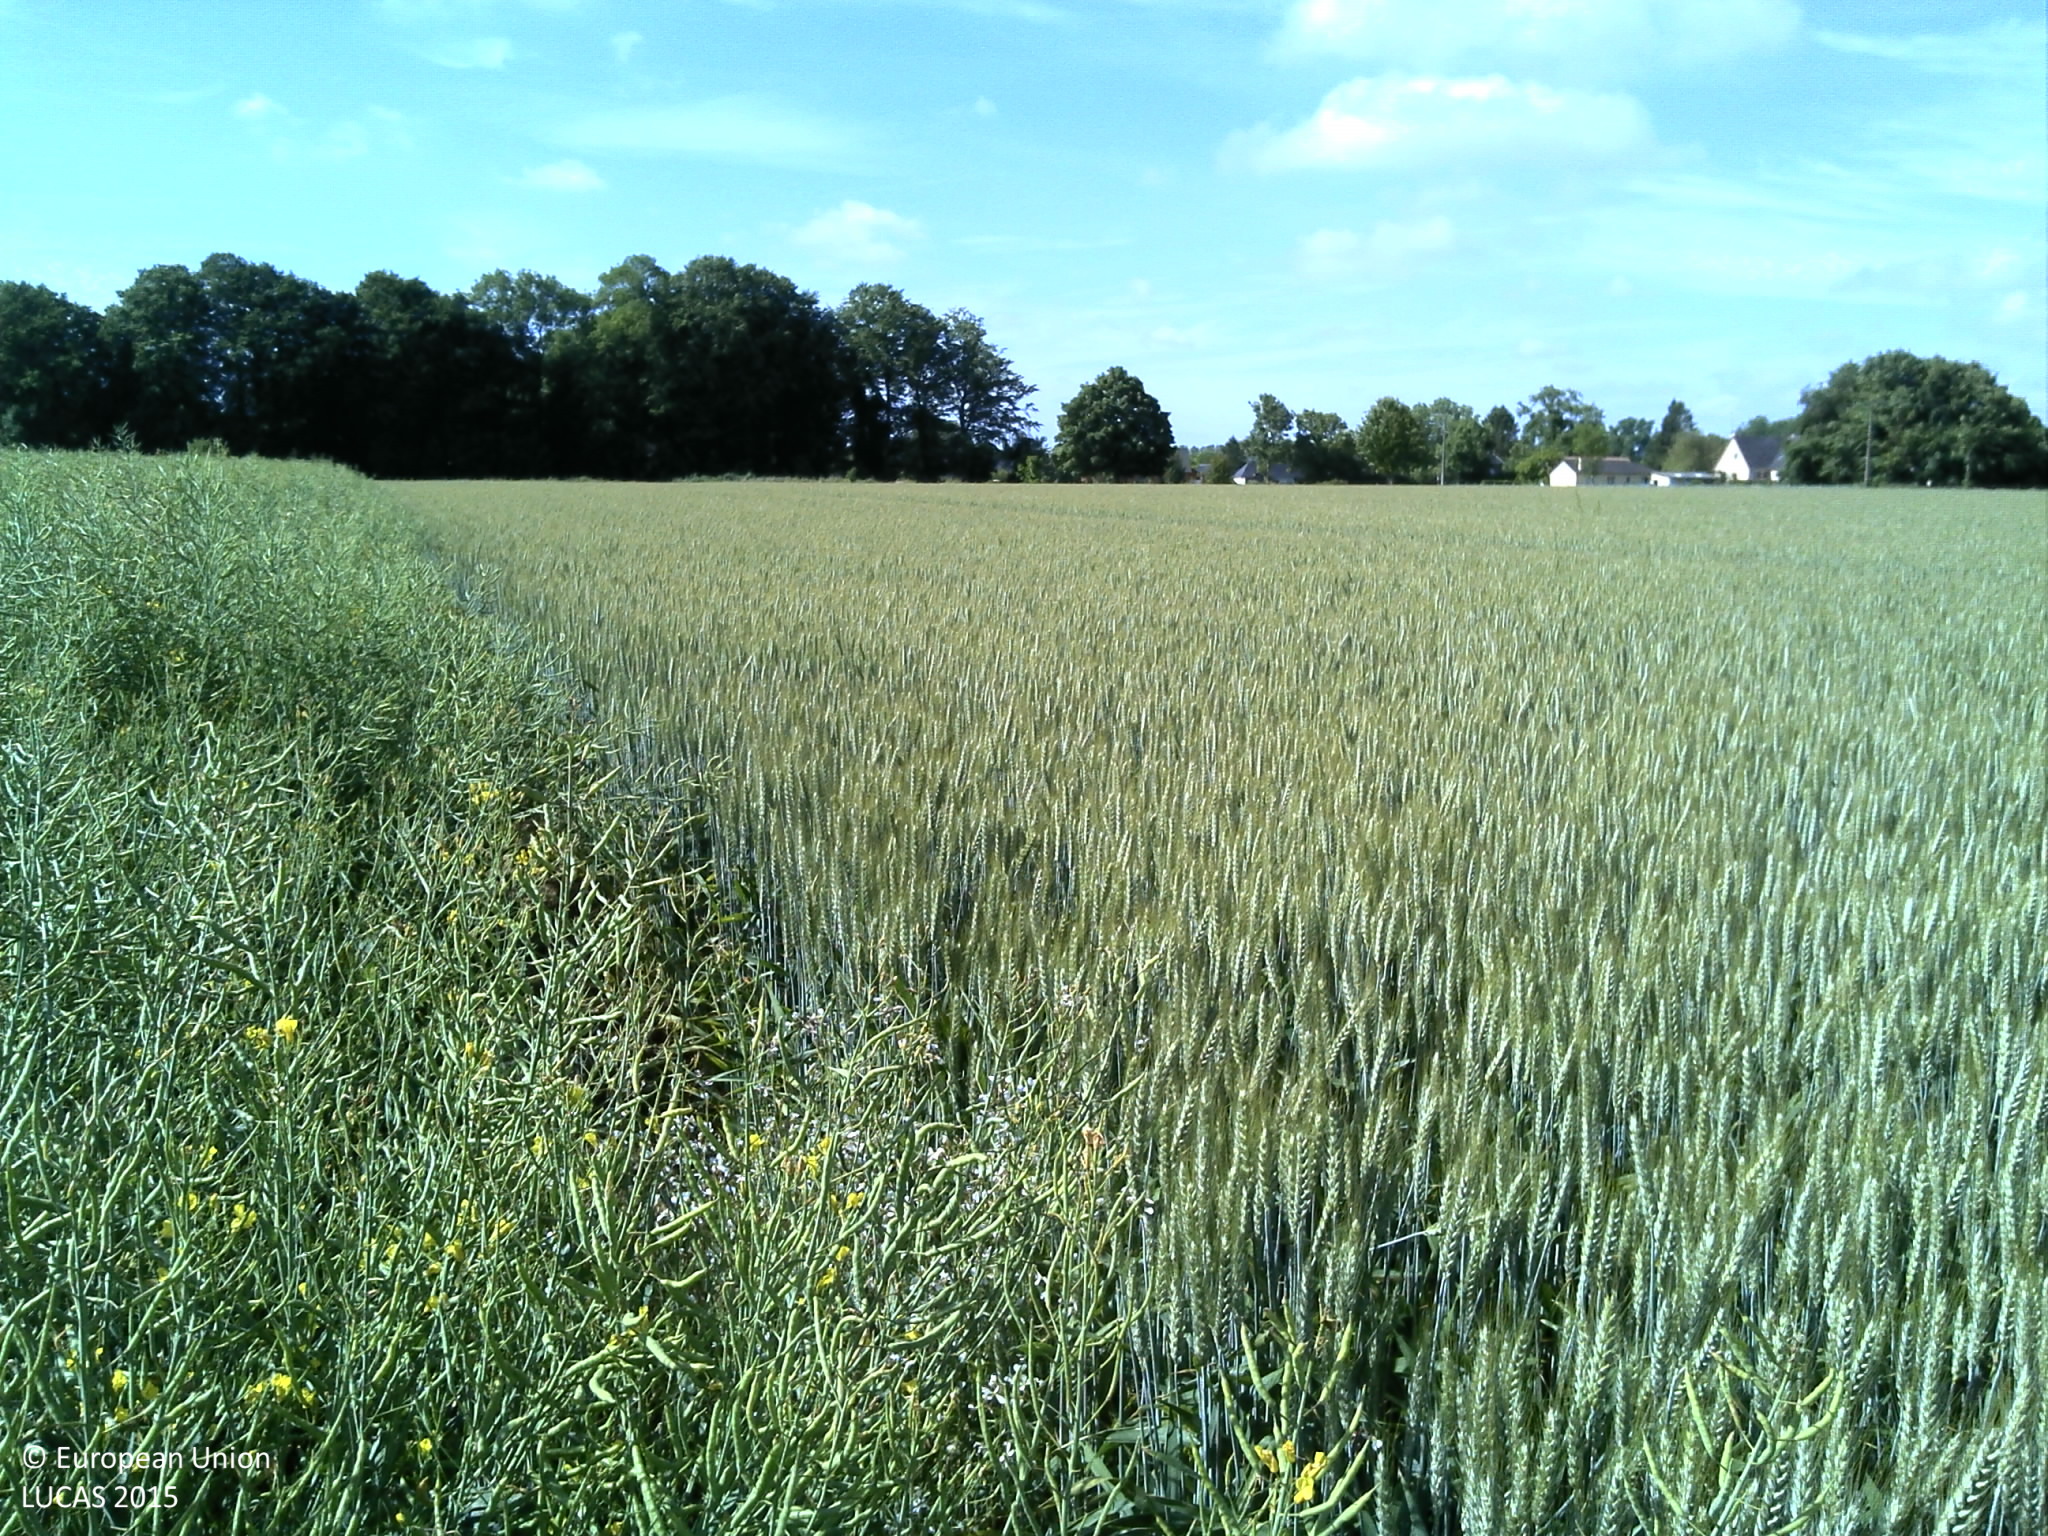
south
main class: Cropland
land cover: Rape and turnip rape
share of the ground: > 75 %
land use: Agriculture (excluding fallow land and kitchen gardens)
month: June
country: FR
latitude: 49.8395
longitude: 1.1490
